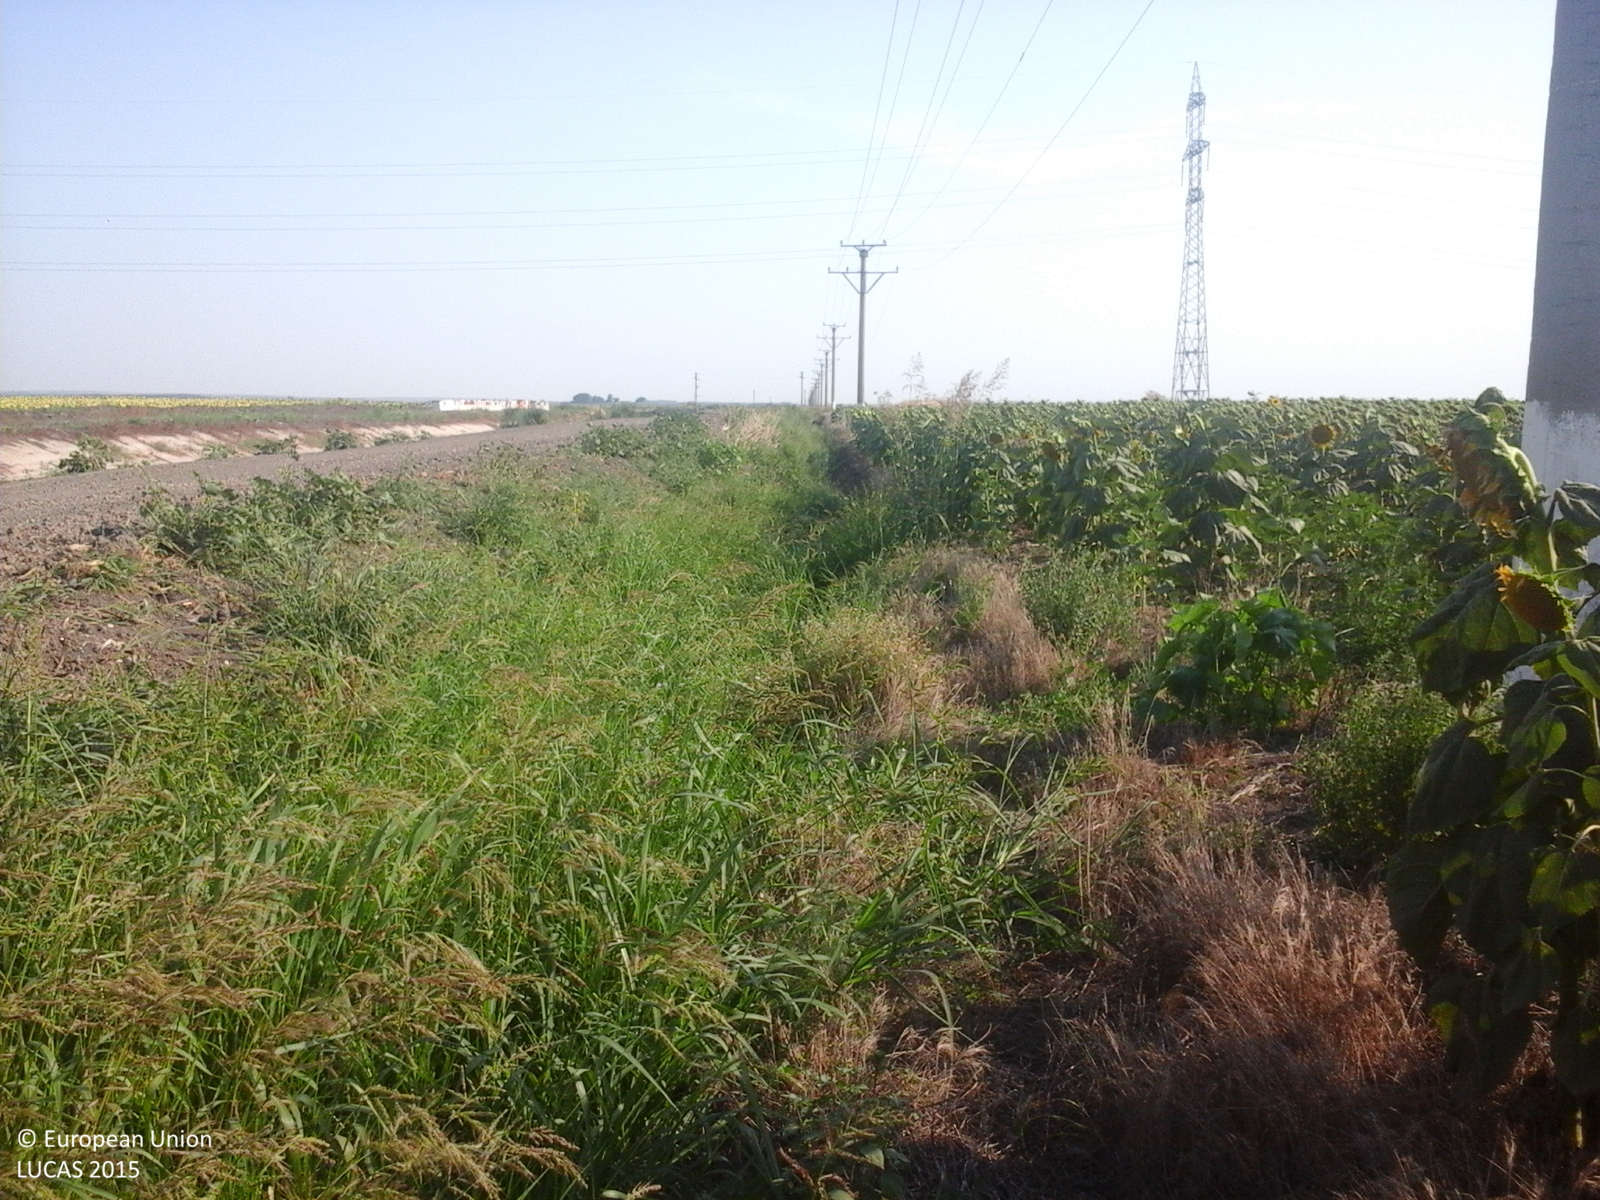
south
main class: Cropland
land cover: Sunflower
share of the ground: > 75 %
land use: Agriculture (excluding fallow land and kitchen gardens)
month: August
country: RO
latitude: 44.9208
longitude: 28.0914
